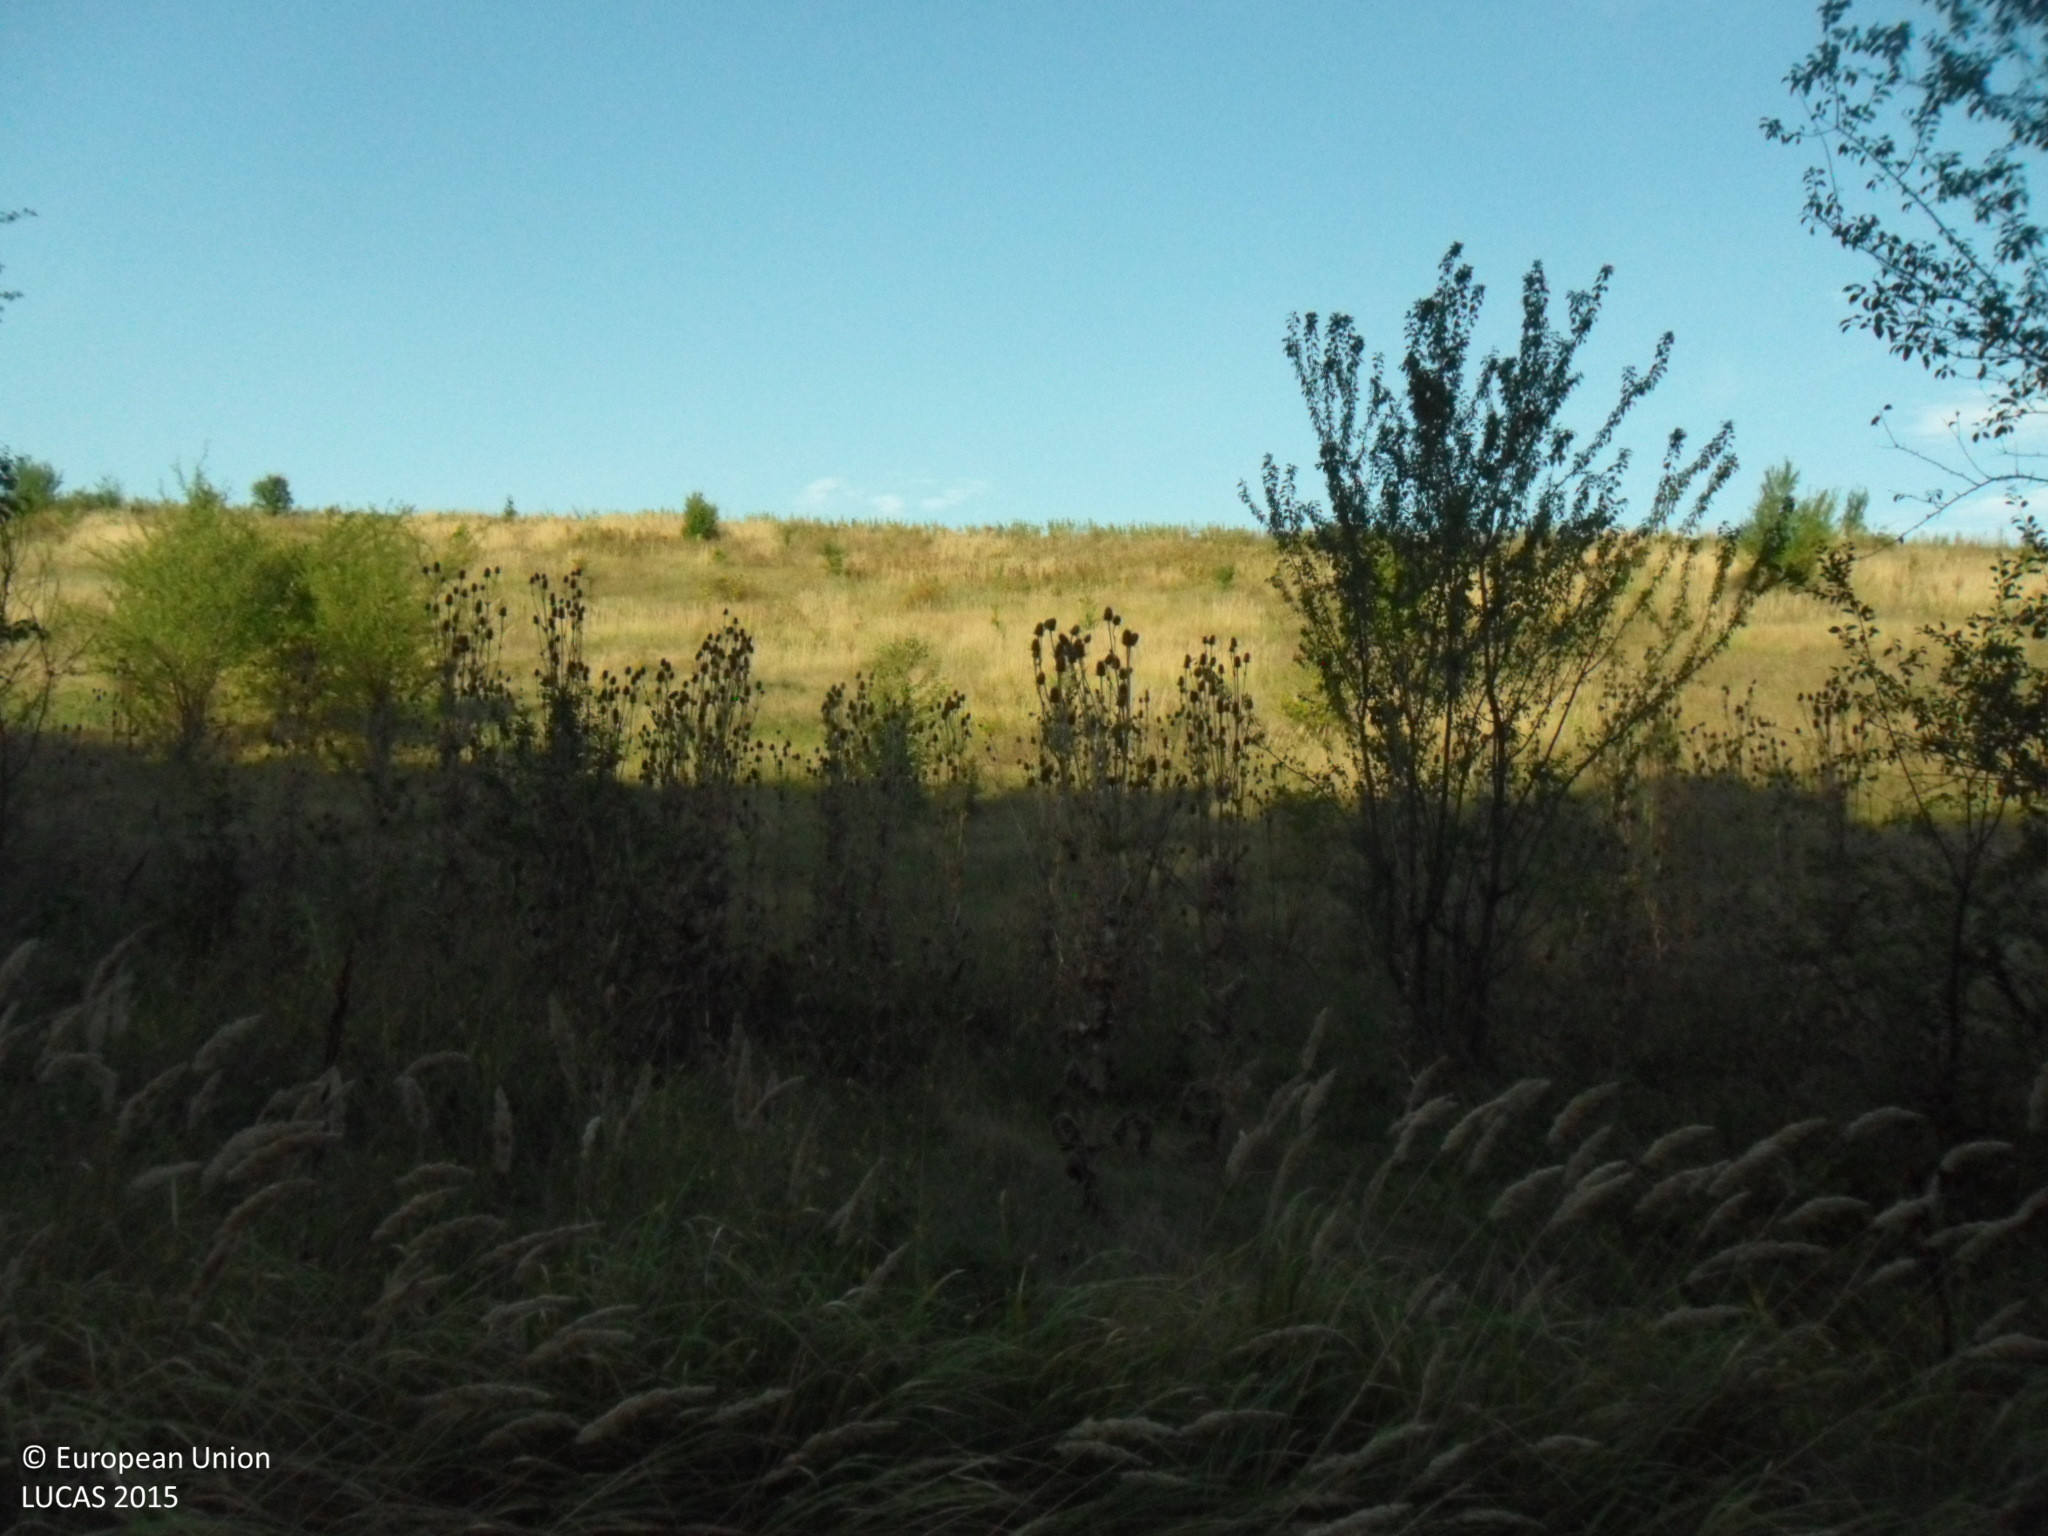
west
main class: Shrubland
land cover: Shrubland with sparse tree cover
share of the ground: > 75 %
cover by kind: shrubs 75 %, herbaceous plants 20 %, broadleaved forest trees 5 %
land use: Agriculture (excluding fallow land and kitchen gardens)
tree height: < 5 m
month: September
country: BG
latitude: 43.6211
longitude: 26.2978
